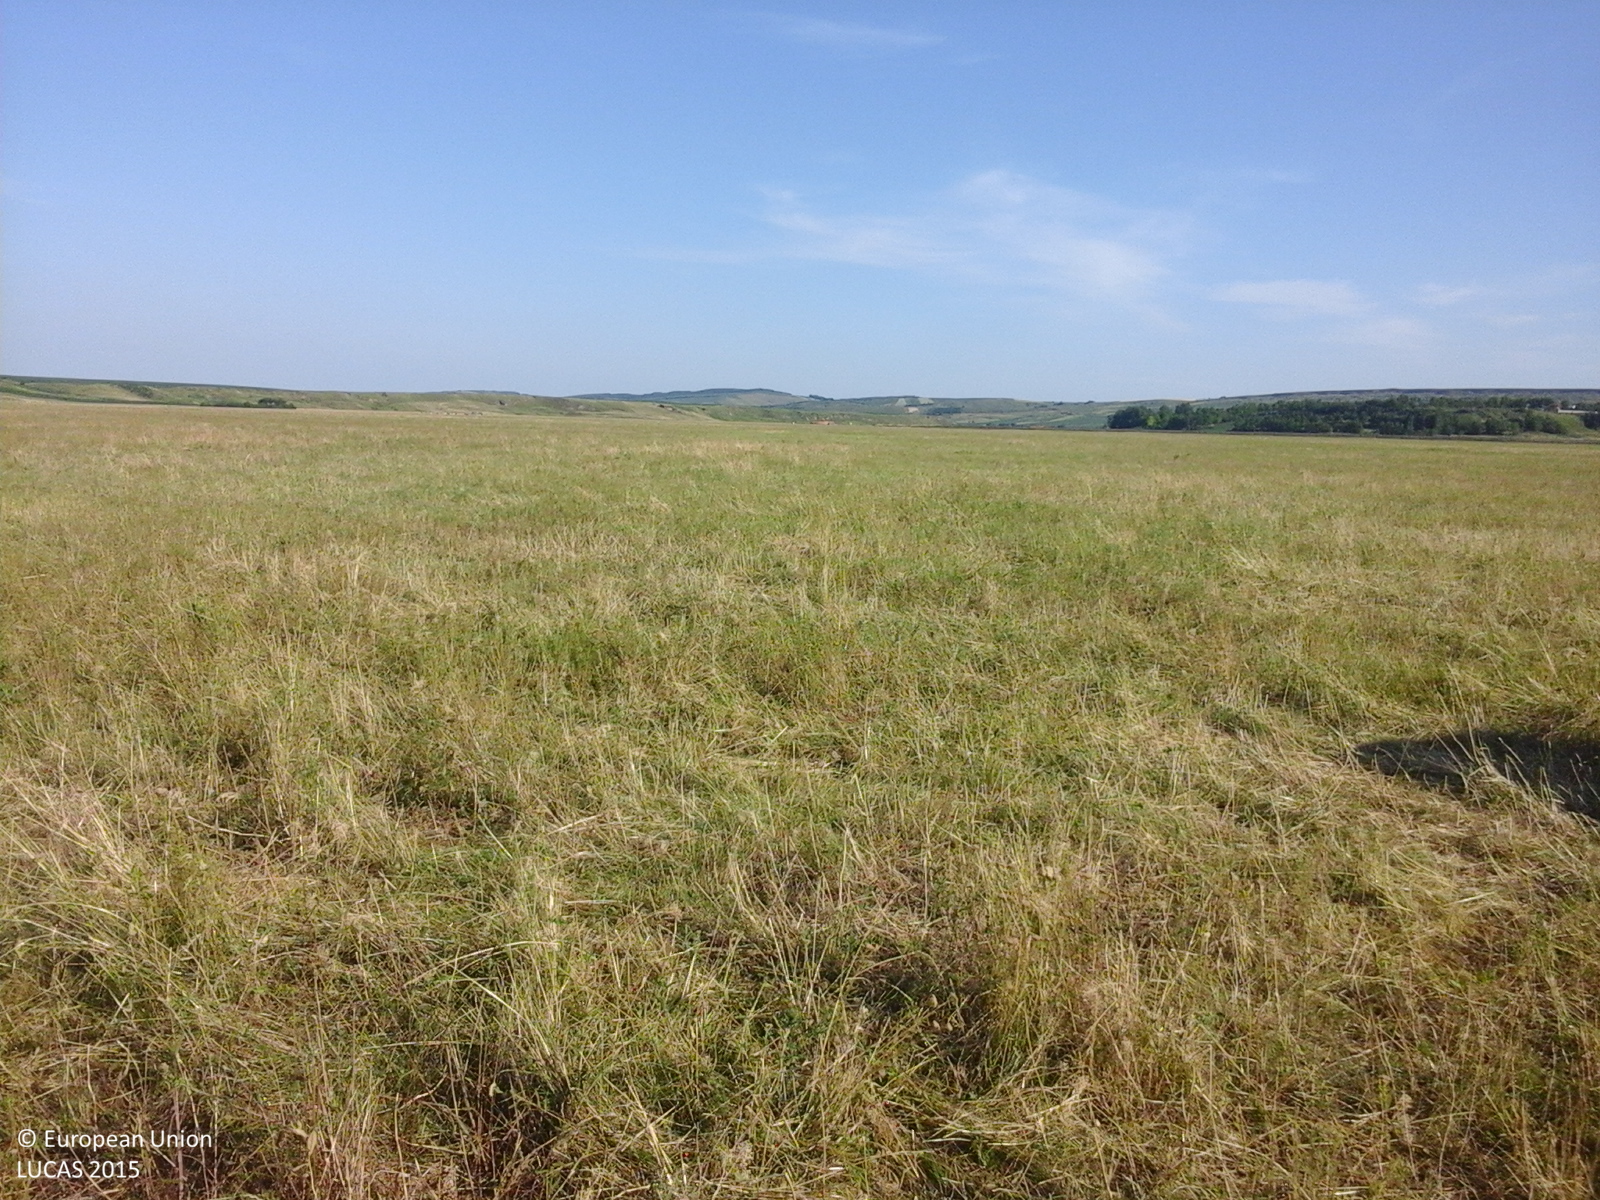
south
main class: Grassland
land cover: Grassland without tree/shrub cover
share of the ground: > 75 %
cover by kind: herbaceous plants 100 %
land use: Agriculture (excluding fallow land and kitchen gardens)
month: June
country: RO
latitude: 47.5981
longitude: 27.1728
